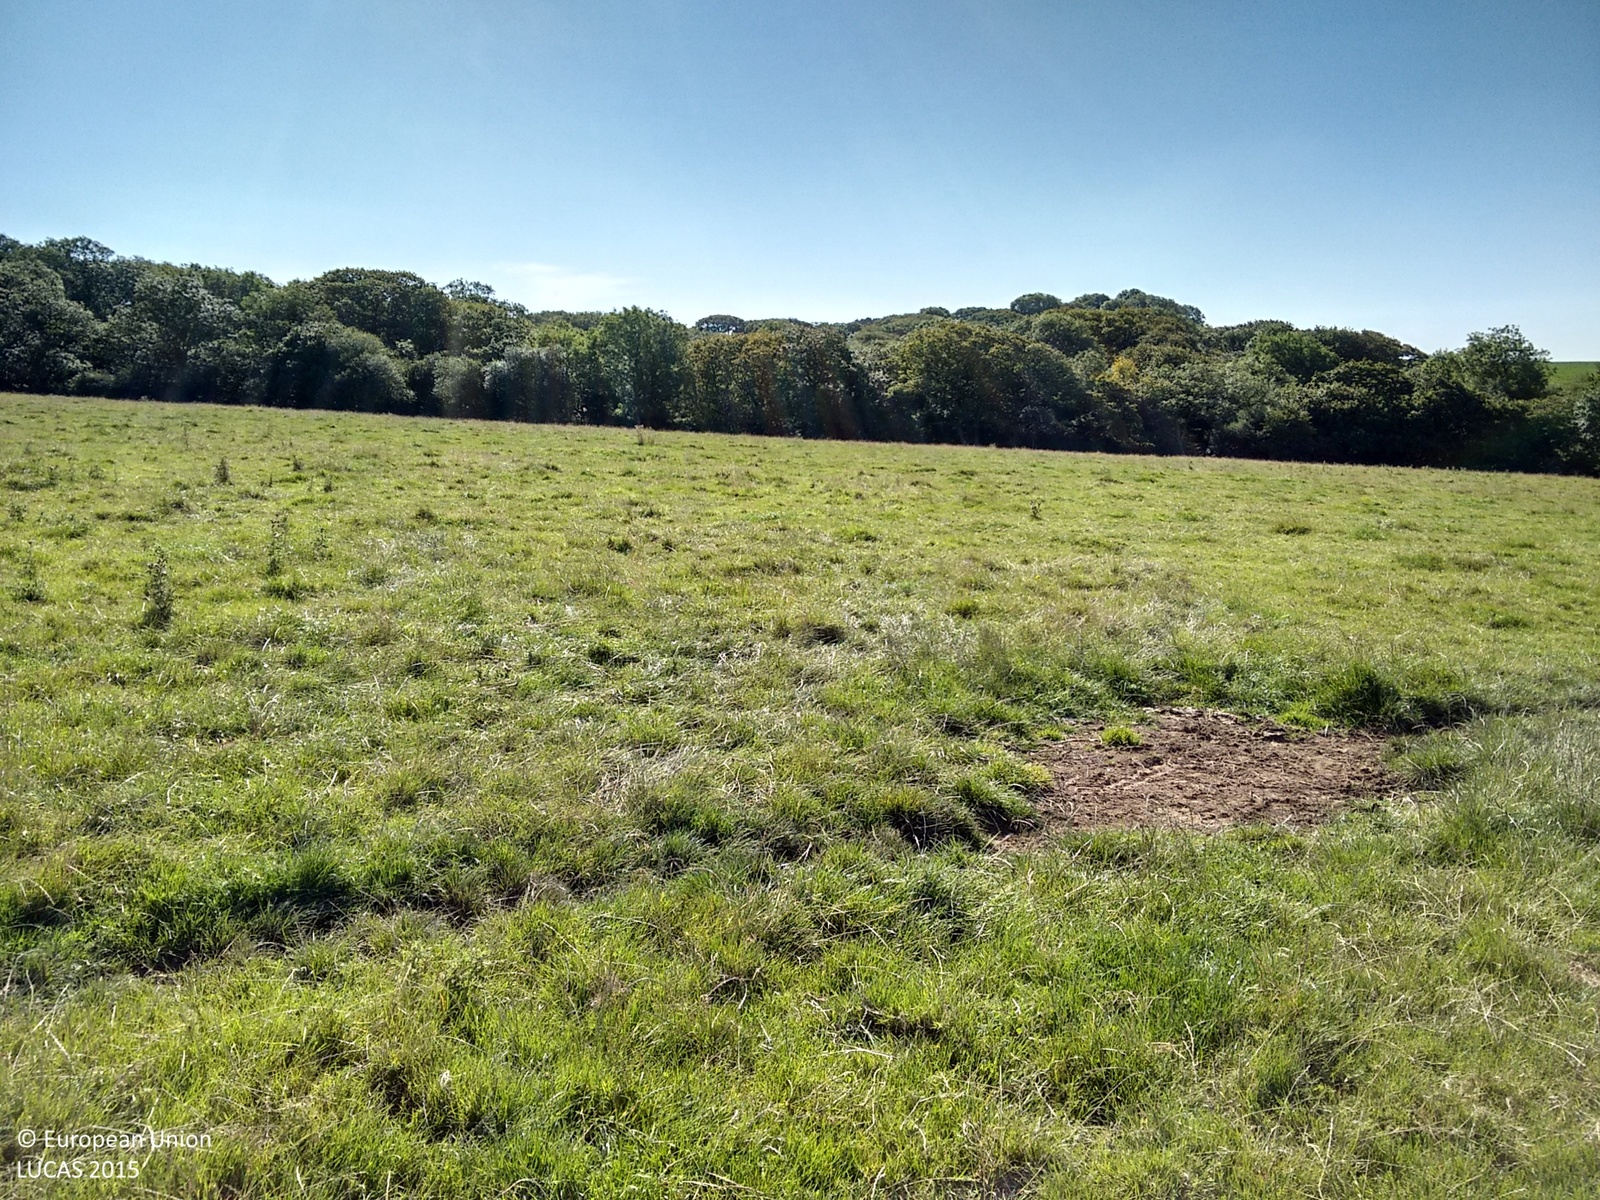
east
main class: Grassland
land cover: Grassland without tree/shrub cover
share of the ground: > 75 %
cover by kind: herbaceous plants 100 %
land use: Agriculture (excluding fallow land and kitchen gardens)
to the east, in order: Grassland without tree/shrub cover; Broadleaved woodland; Rivers and streams; Broadleaved woodland; Fences; Broadleaved woodland; Rivers and streams; Broadleaved woodland
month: August
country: GB
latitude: 51.7443
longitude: -4.8725
